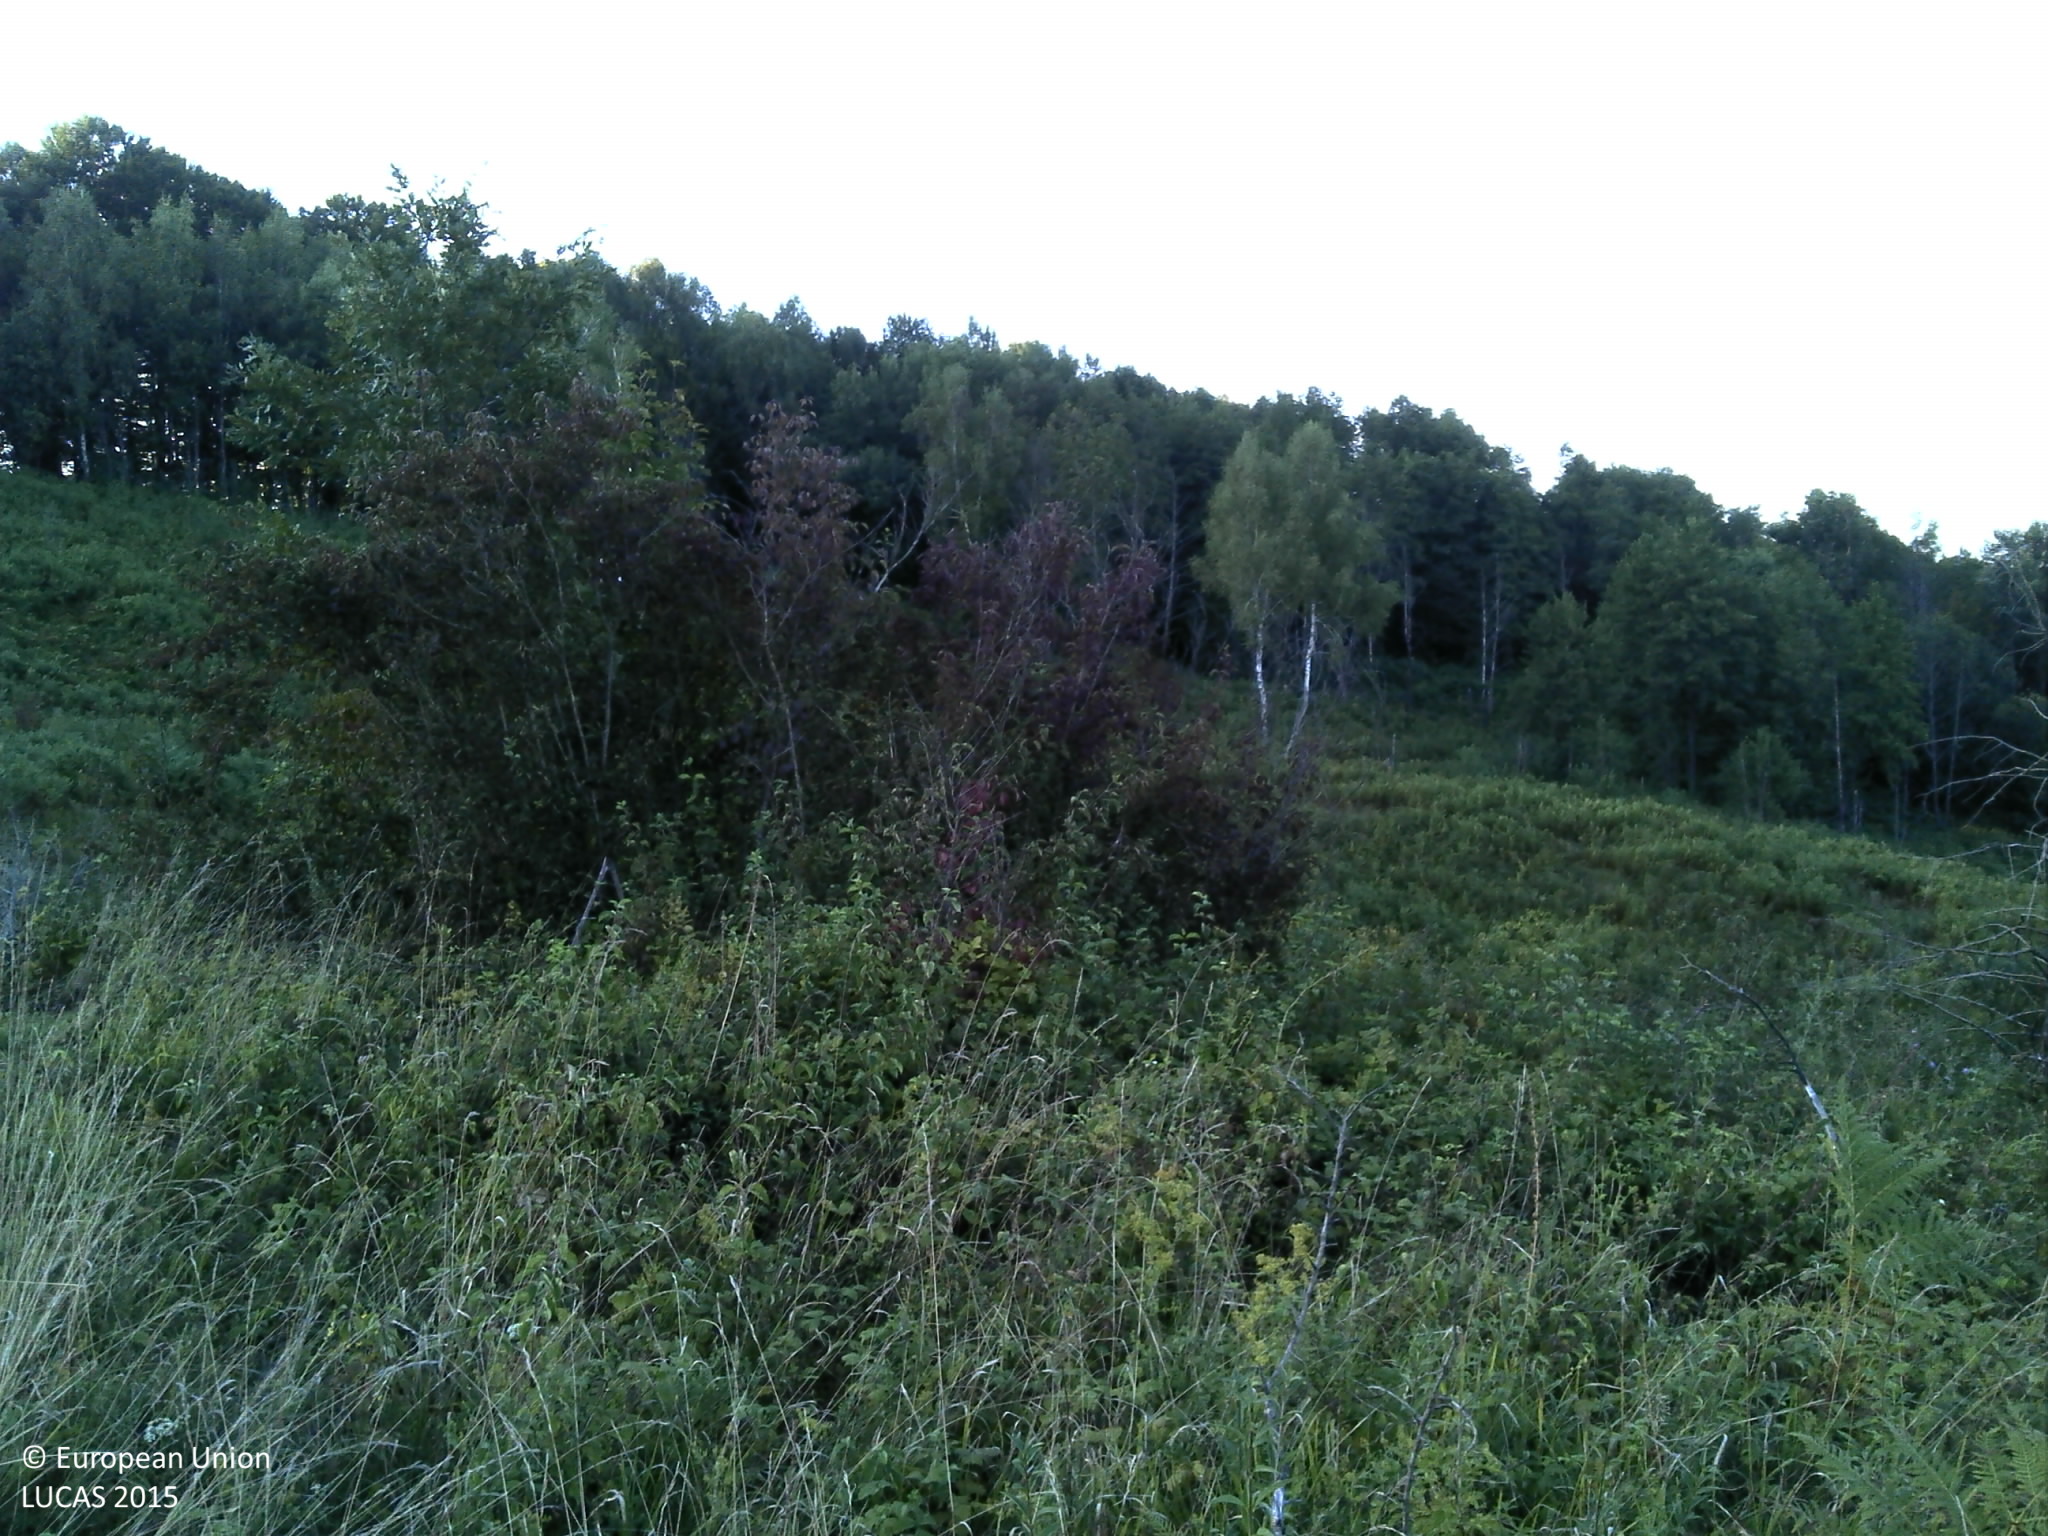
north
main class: Grassland
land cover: Grassland with sparse tree/shrub cover
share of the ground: > 75 %
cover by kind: herbaceous plants 85 %, shrubs 10 %, broadleaved forest trees 5 %
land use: Semi-natural and natural areas not in use
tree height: < 5 m
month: August
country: HR
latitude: 45.2826
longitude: 15.6179
